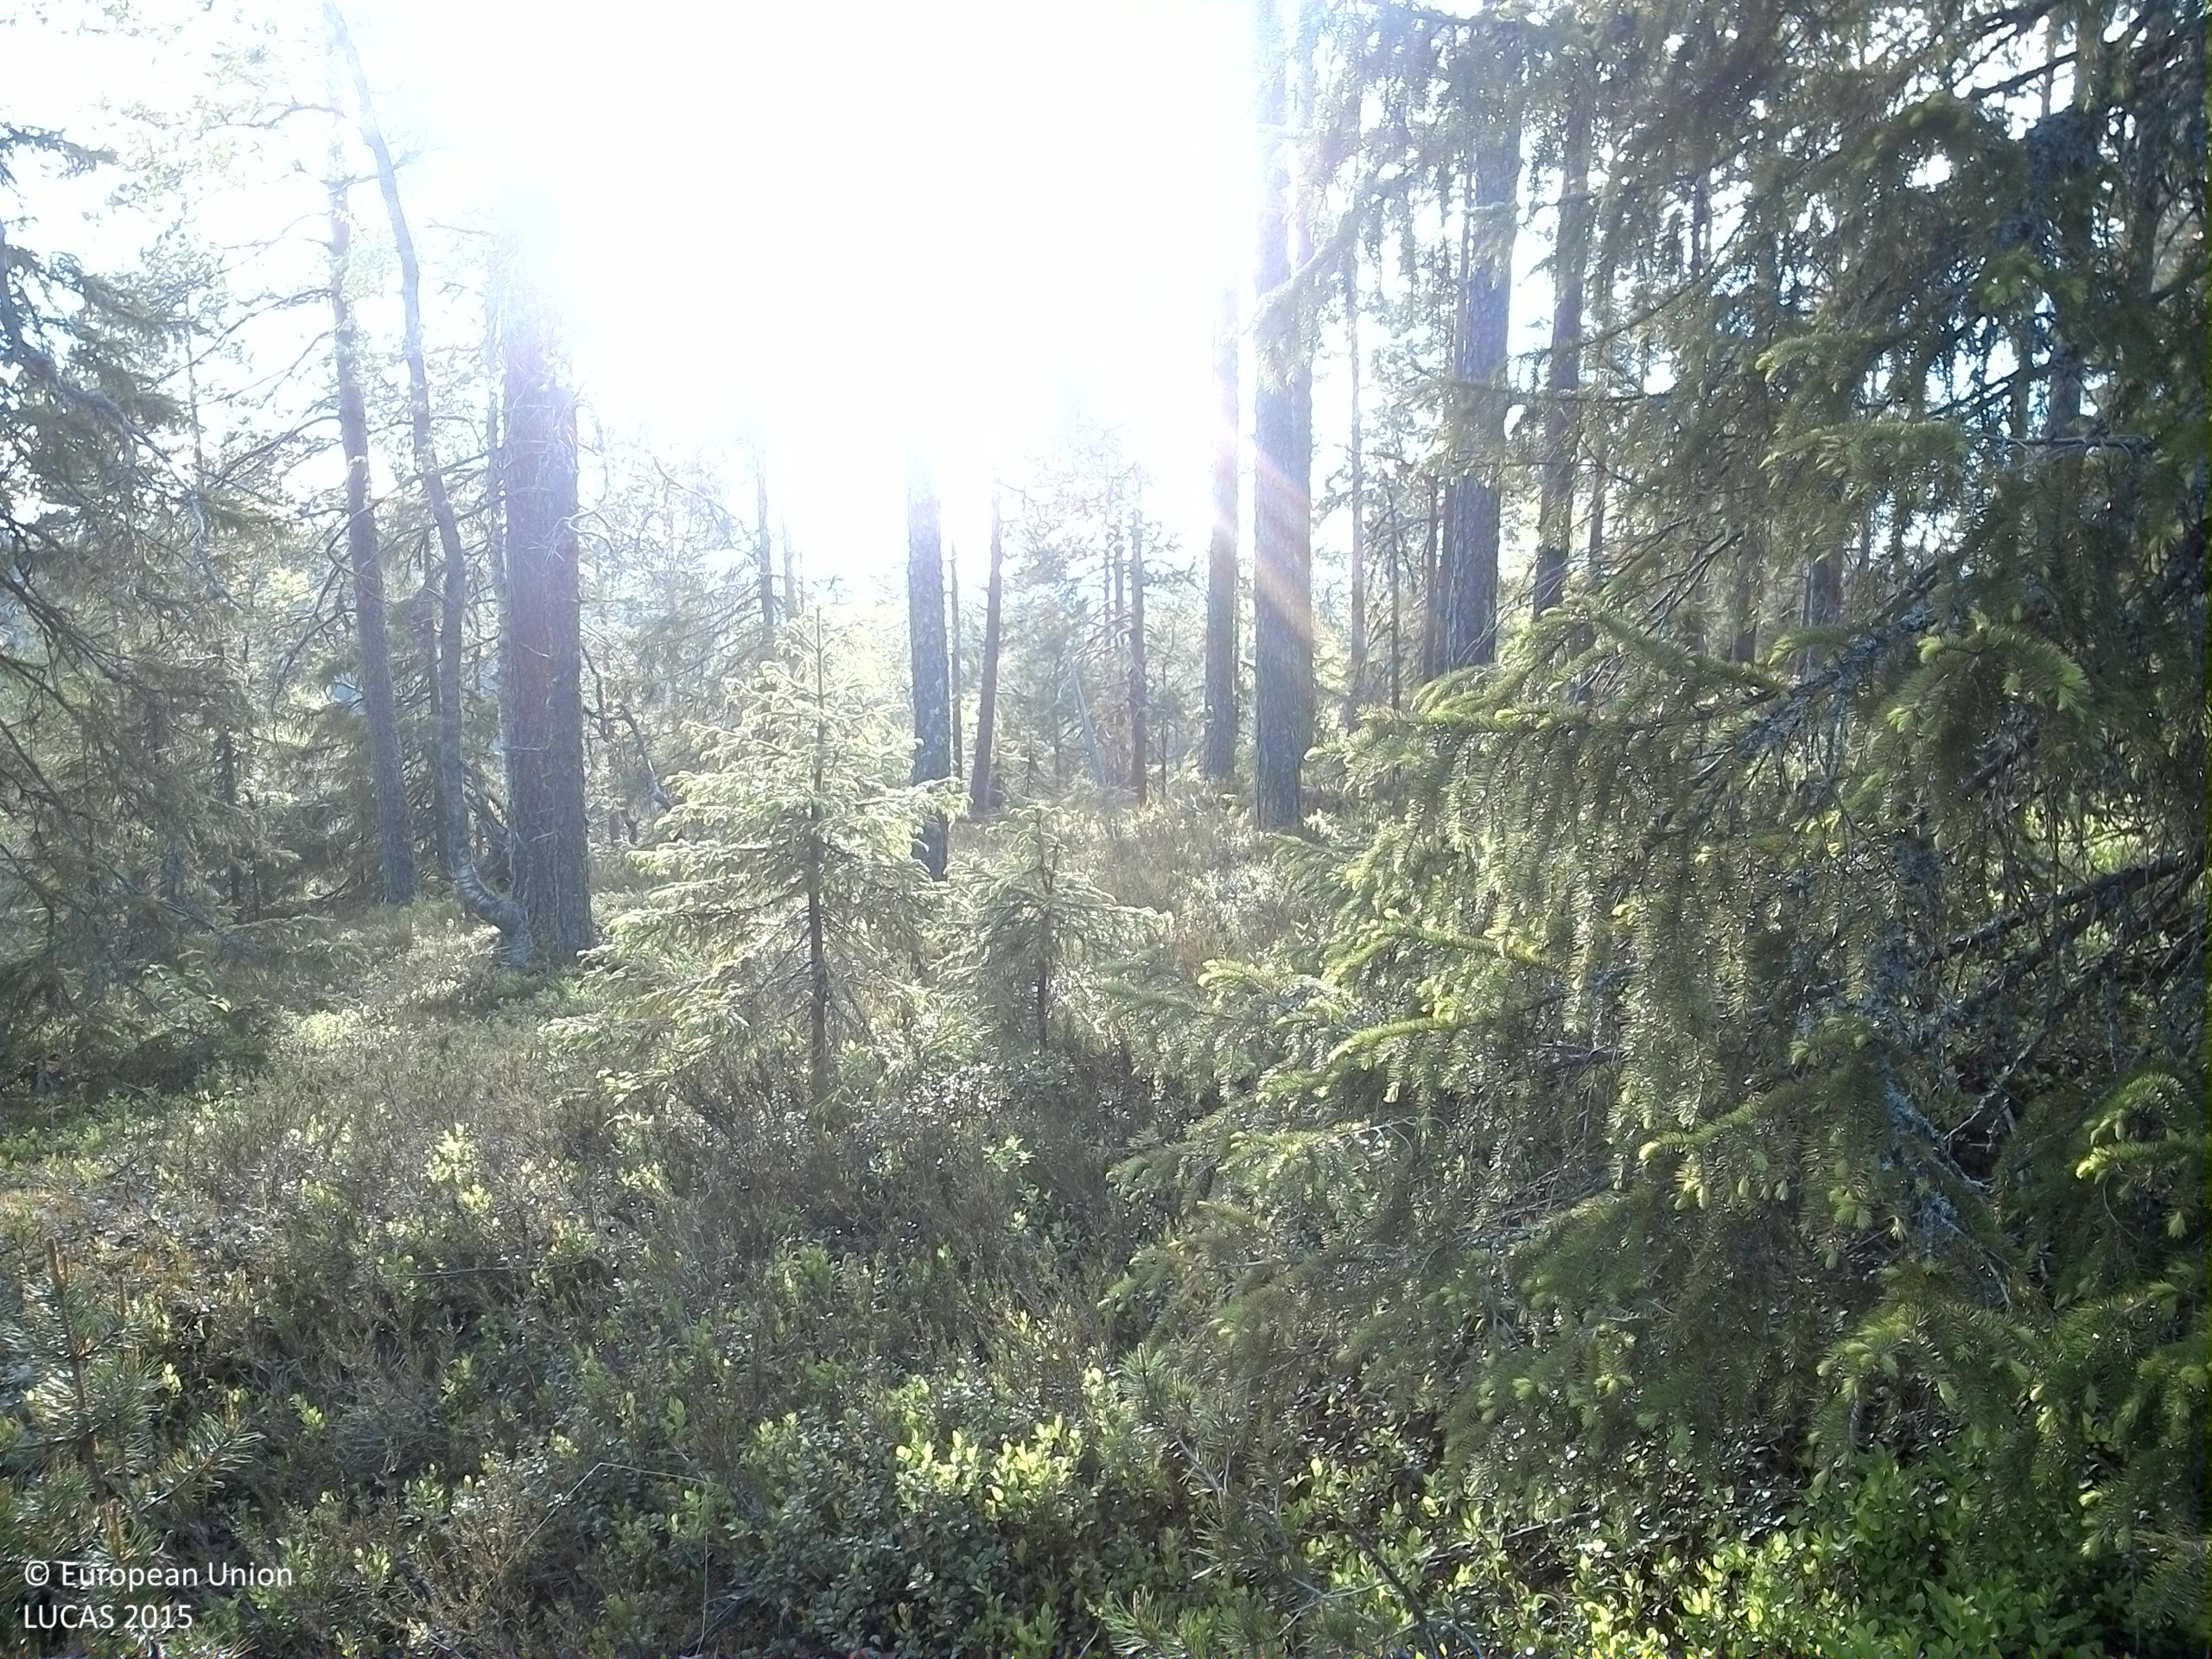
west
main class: Woodland
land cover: Other coniferous woodland
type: boreal forest
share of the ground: 25 - 50 %
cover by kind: shrubs 60 %, coniferous forest trees 25 %, lichens and mosses 10 %, broadleaved forest trees 5 %
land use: Forestry
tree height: > 5 m
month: June
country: SE
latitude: 62.6395
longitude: 17.5664
